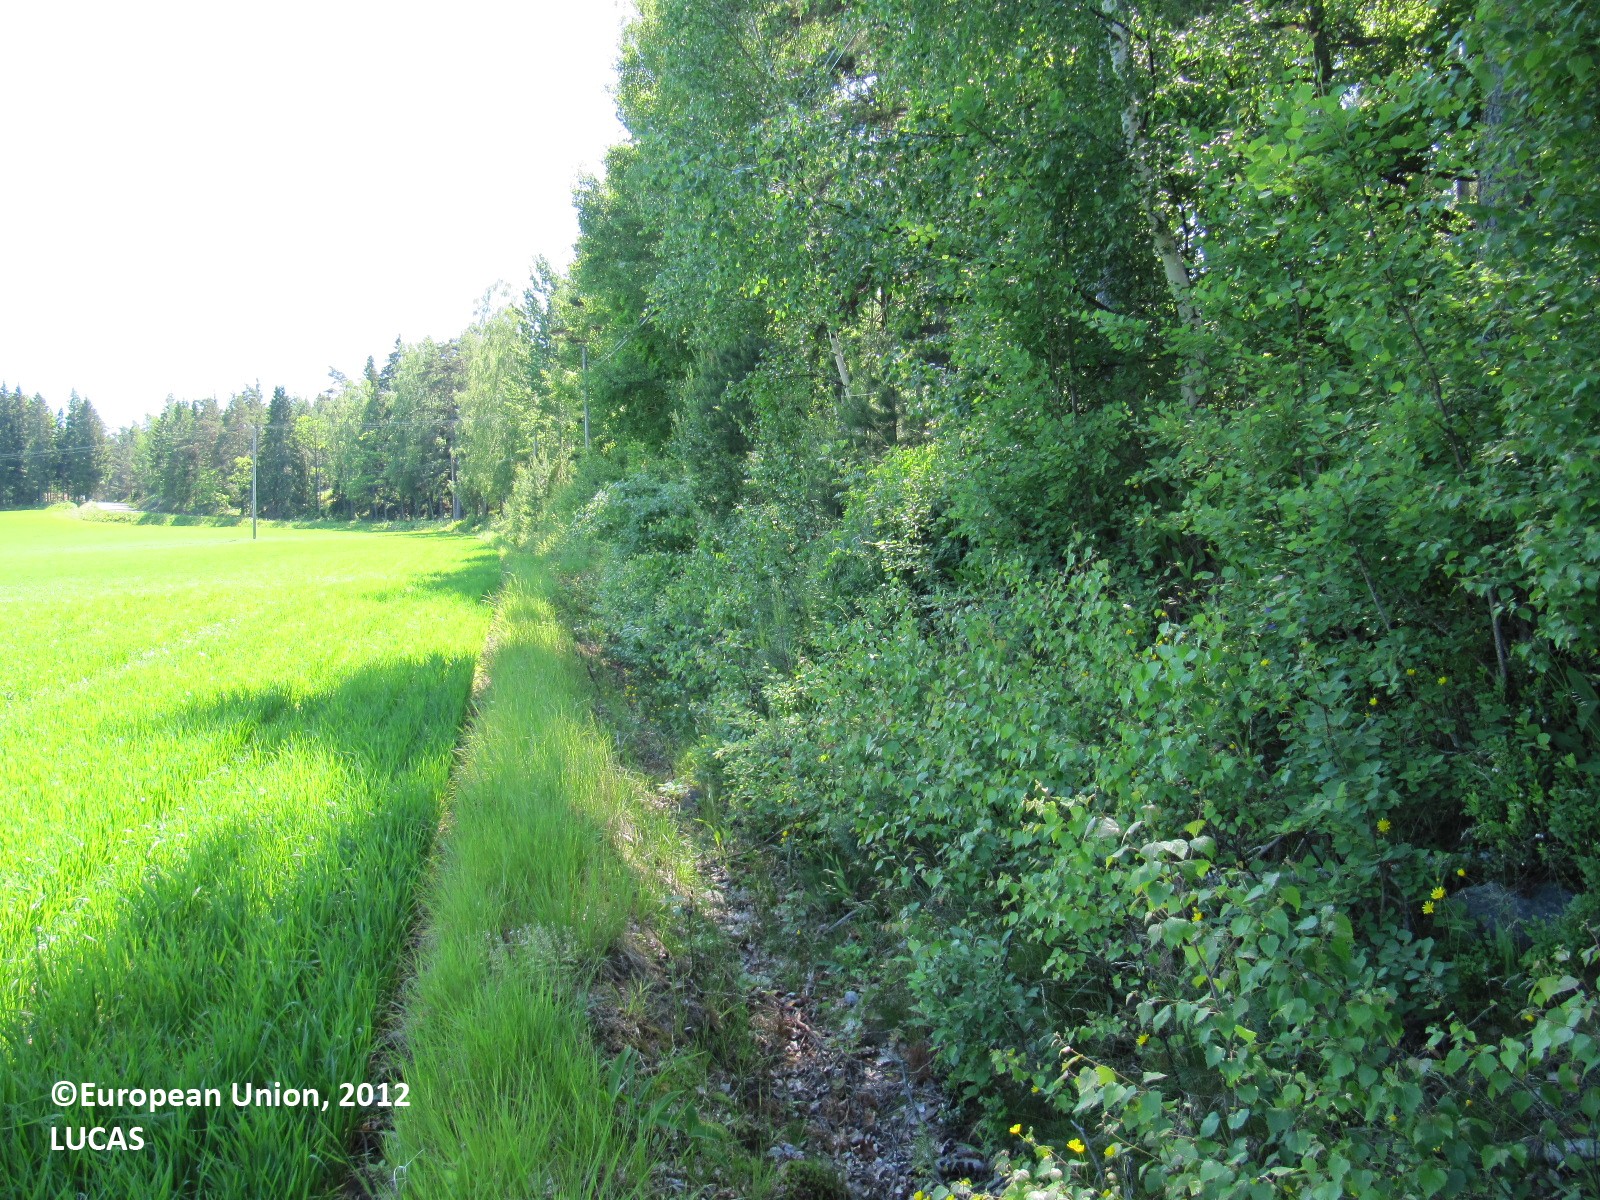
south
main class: Cropland
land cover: Barley
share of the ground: > 75 %
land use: Agriculture (excluding fallow land and kitchen gardens)
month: June
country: FI
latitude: 60.0065
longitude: 23.0846
